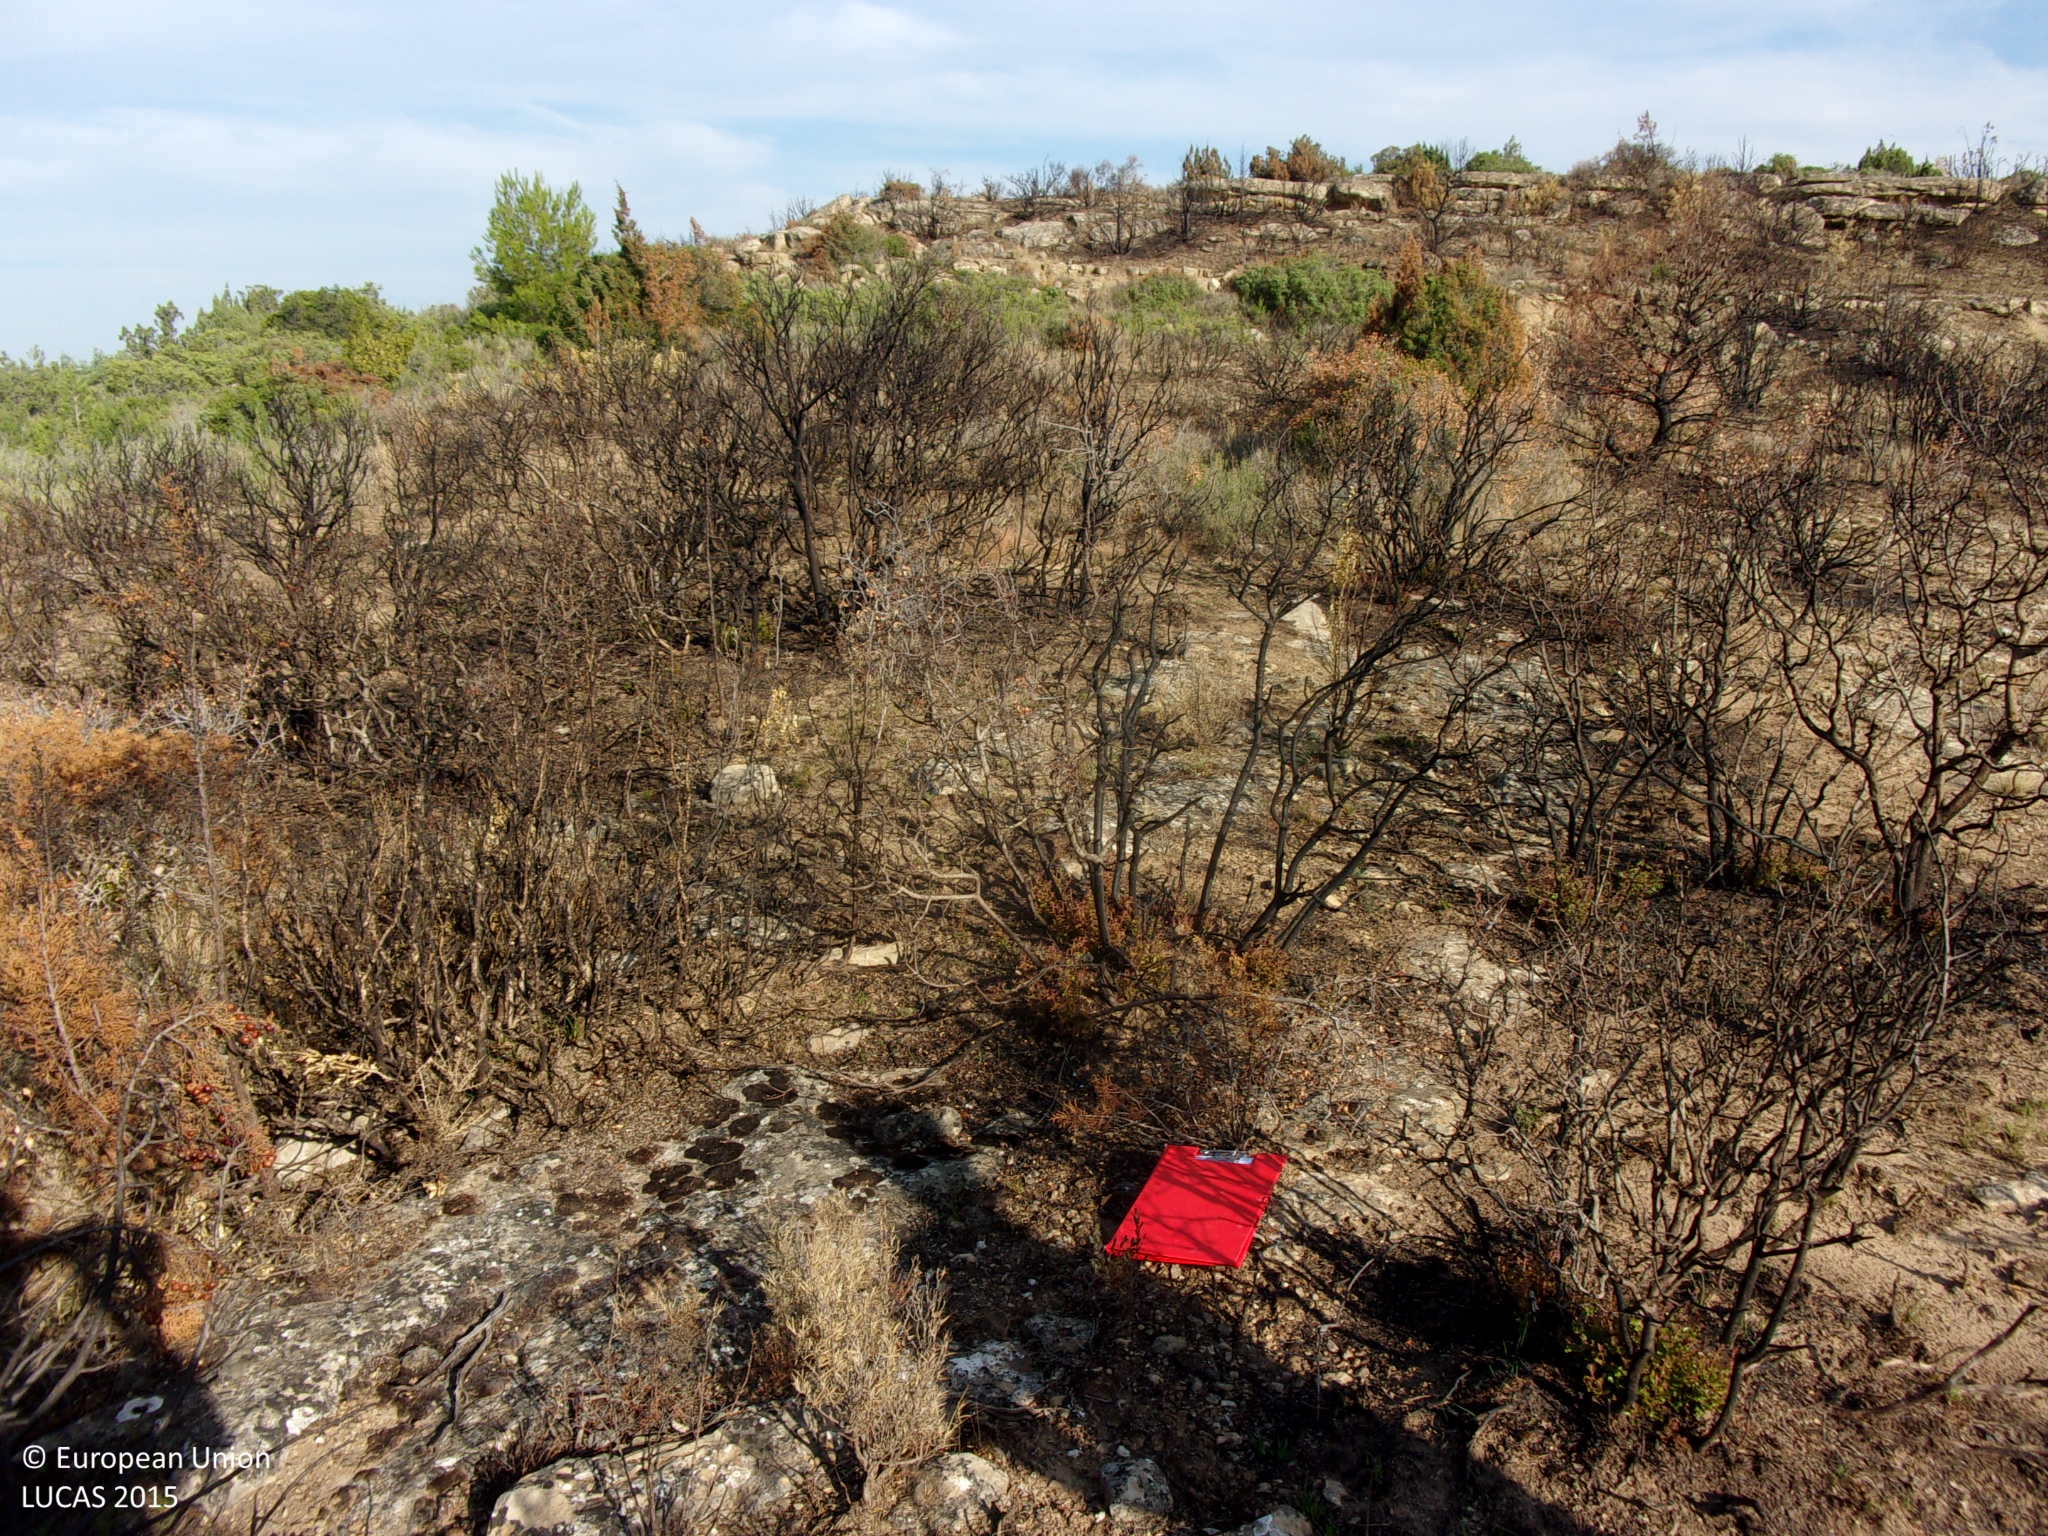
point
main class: Shrubland
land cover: Shrubland without tree cover
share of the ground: 10 - 25 %
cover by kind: unconsolidated bare surface 90 %, shrubs 10 %
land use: Semi-natural and natural areas not in use
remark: Burnt area
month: August
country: ES
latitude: 42.2100
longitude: -1.0629
